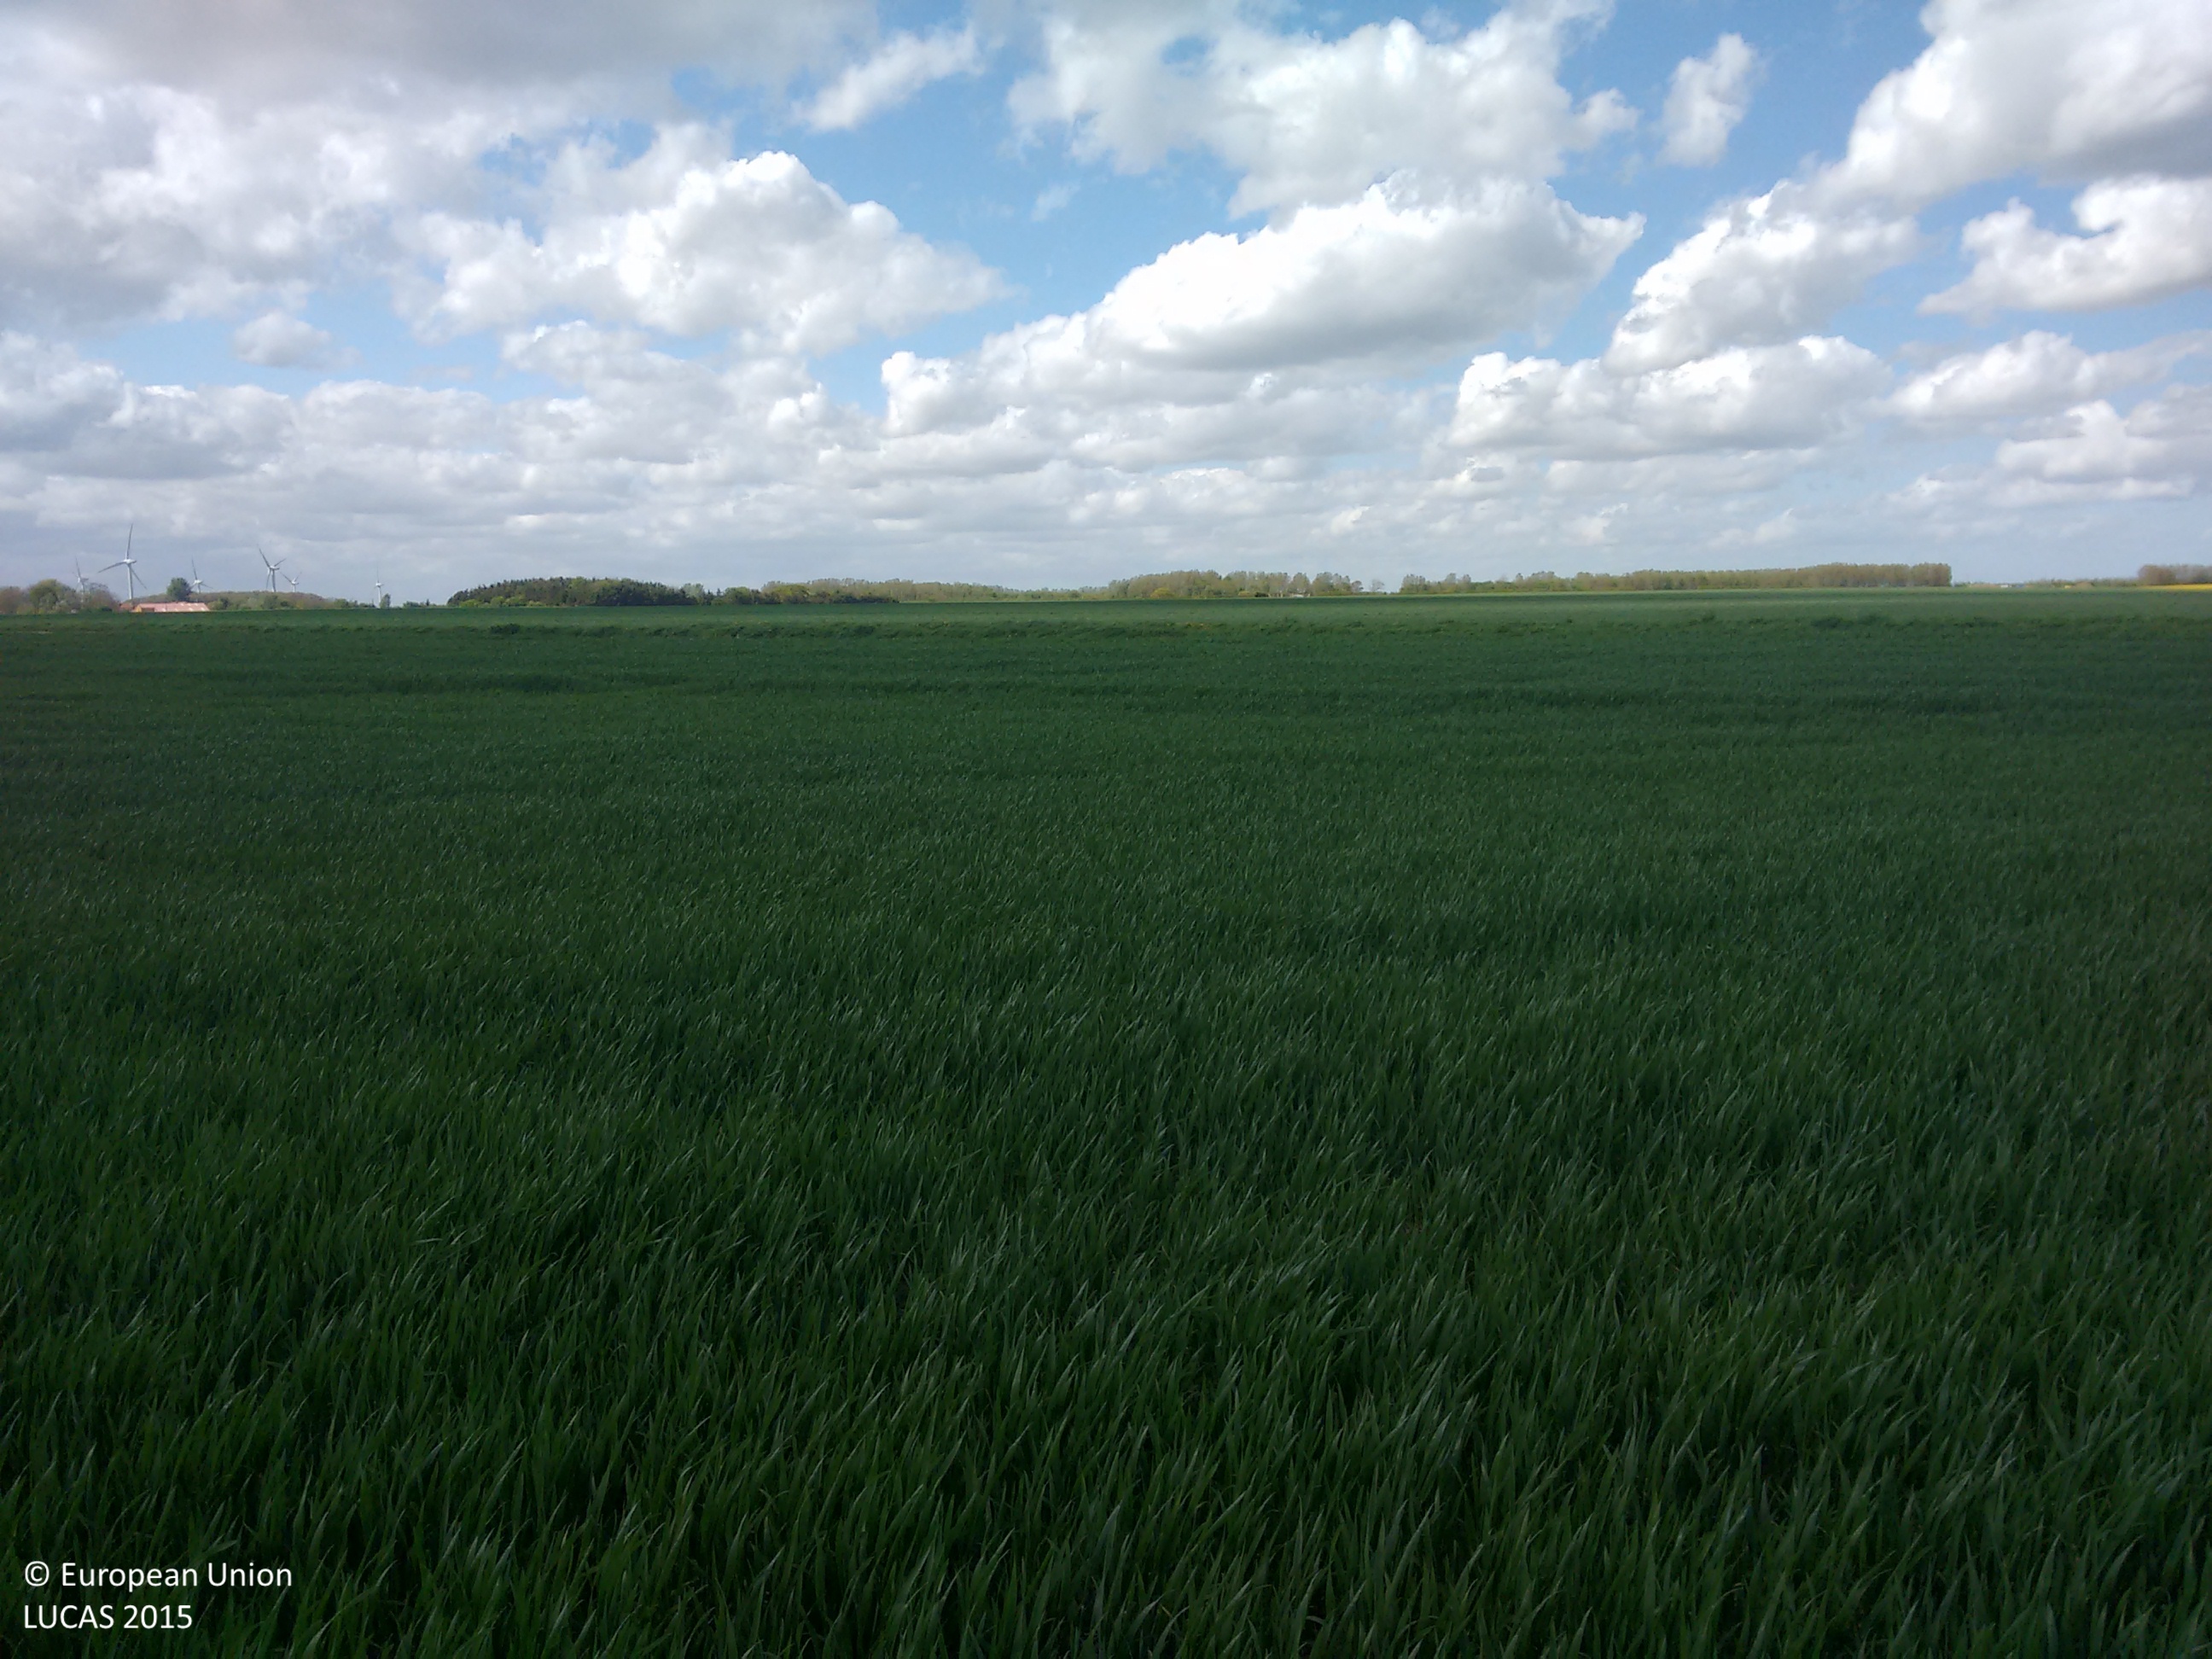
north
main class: Cropland
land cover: Common wheat
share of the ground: > 75 %
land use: Agriculture (excluding fallow land and kitchen gardens)
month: May
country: GB
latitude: 53.8655
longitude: -0.3297
